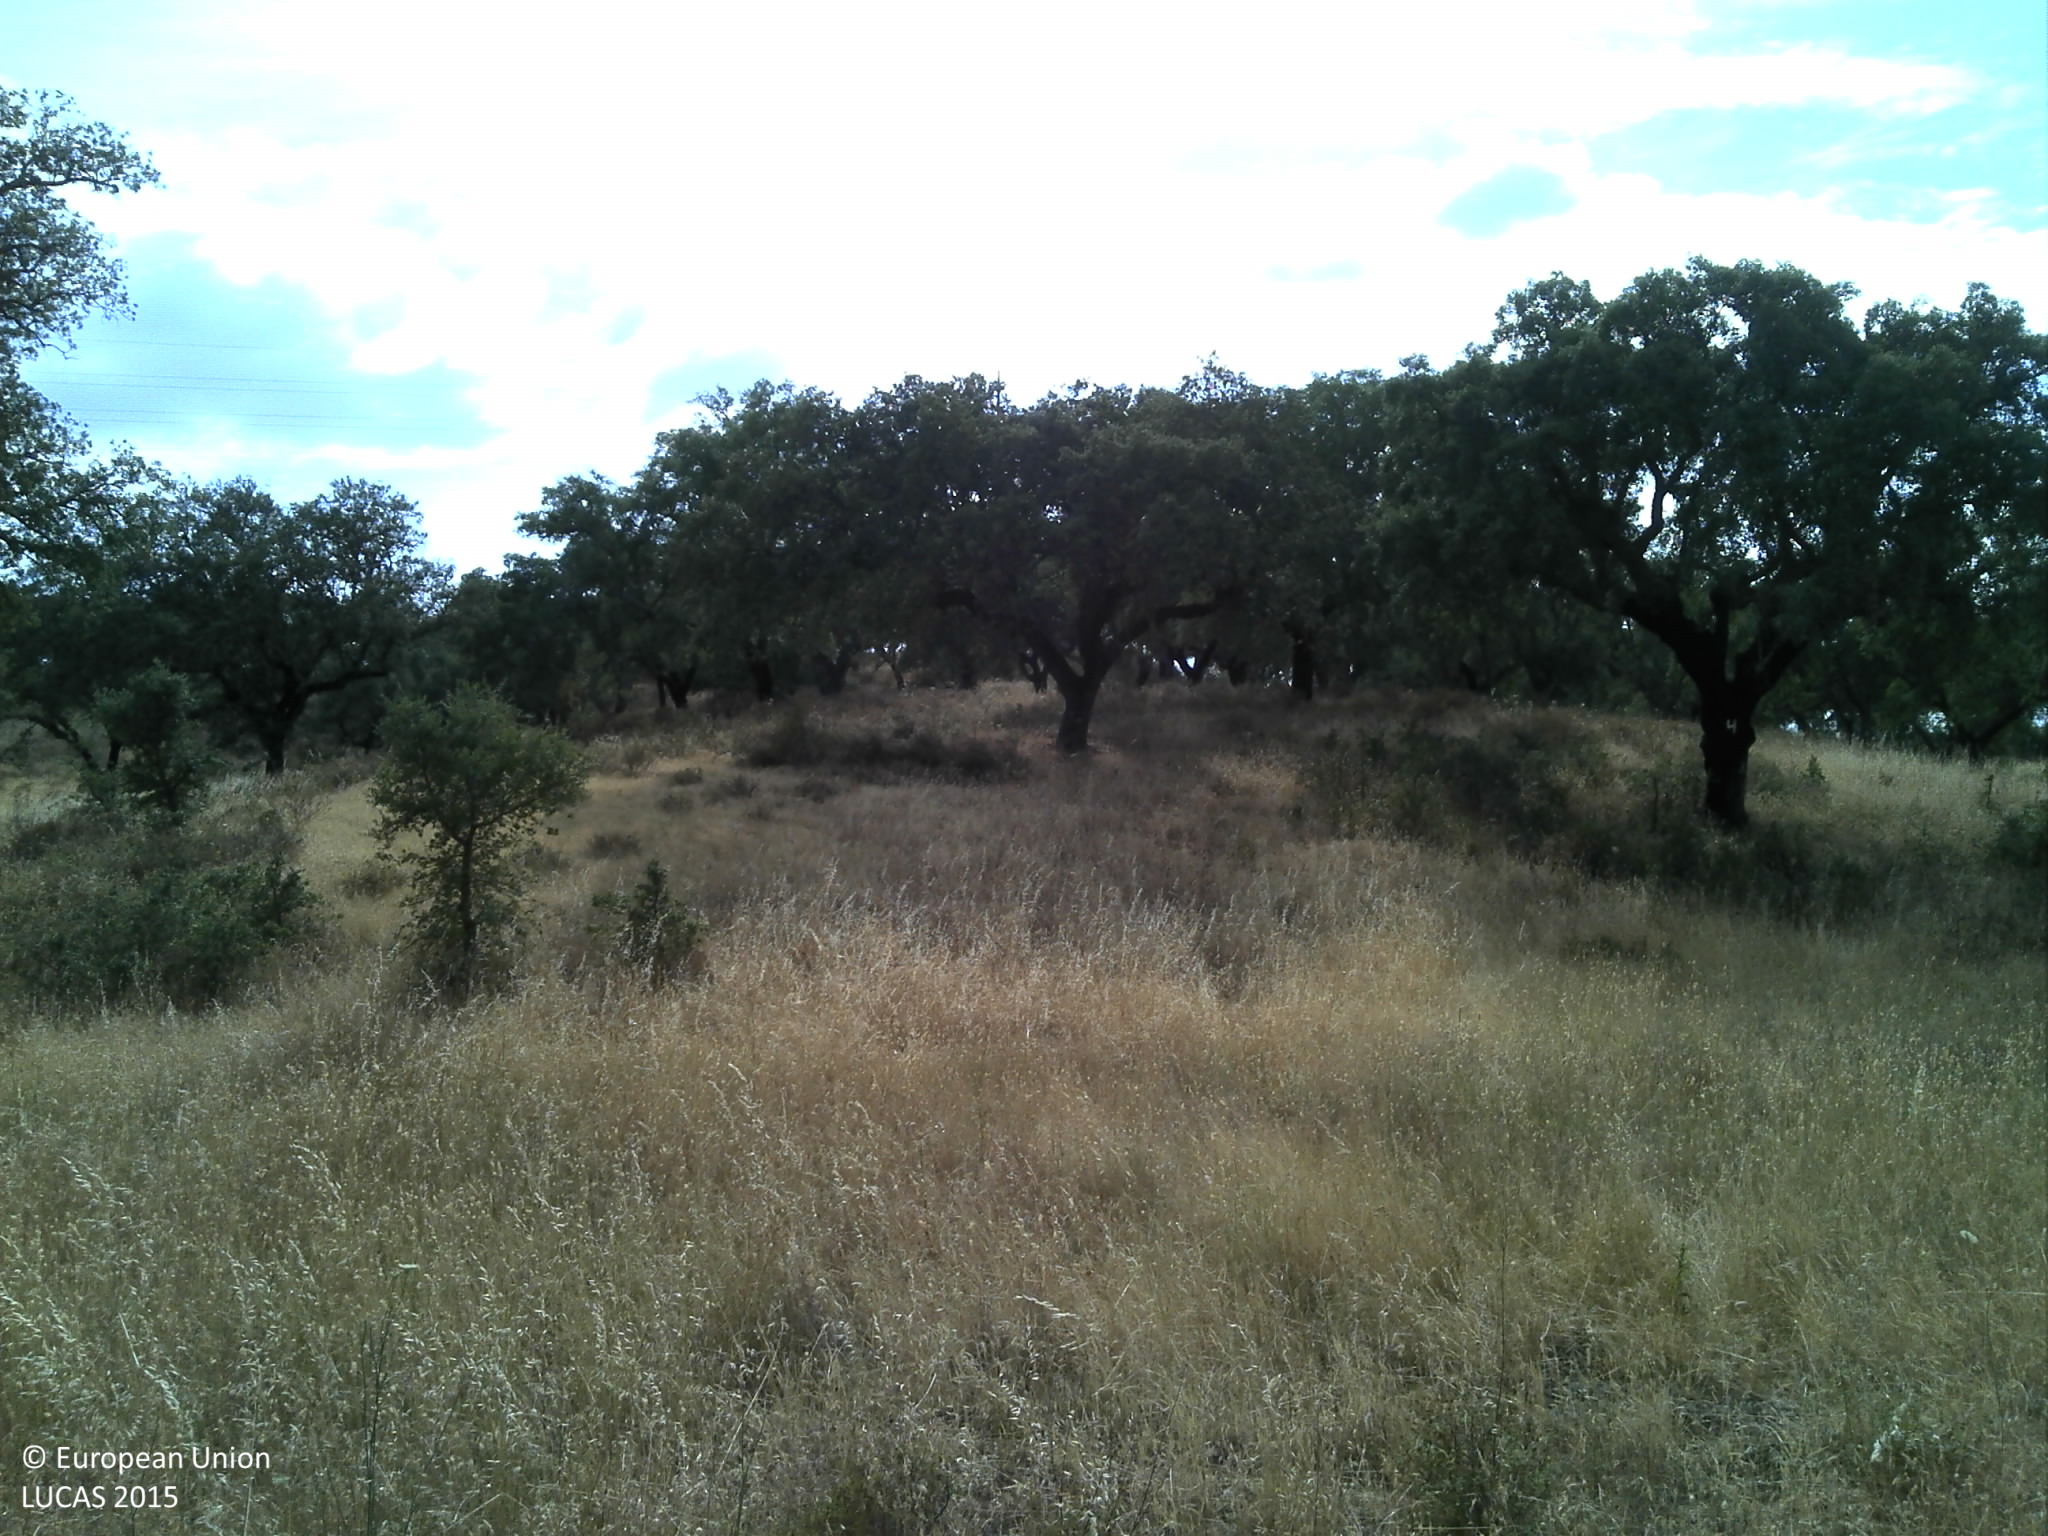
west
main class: Woodland
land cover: Broadleaved woodland
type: broadleaved evergreen forest
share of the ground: 25 - 50 %
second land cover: Grassland without tree/shrub cover
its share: 25 - 50 %
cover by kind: unconsolidated bare surface 35 %, herbaceous plants 30 %, broadleaved forest trees 25 %, shrubs 10 %
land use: Forestry
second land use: Agriculture (excluding fallow land and kitchen gardens)
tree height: > 5 m
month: June
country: PT
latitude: 38.3864
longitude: -7.7896
